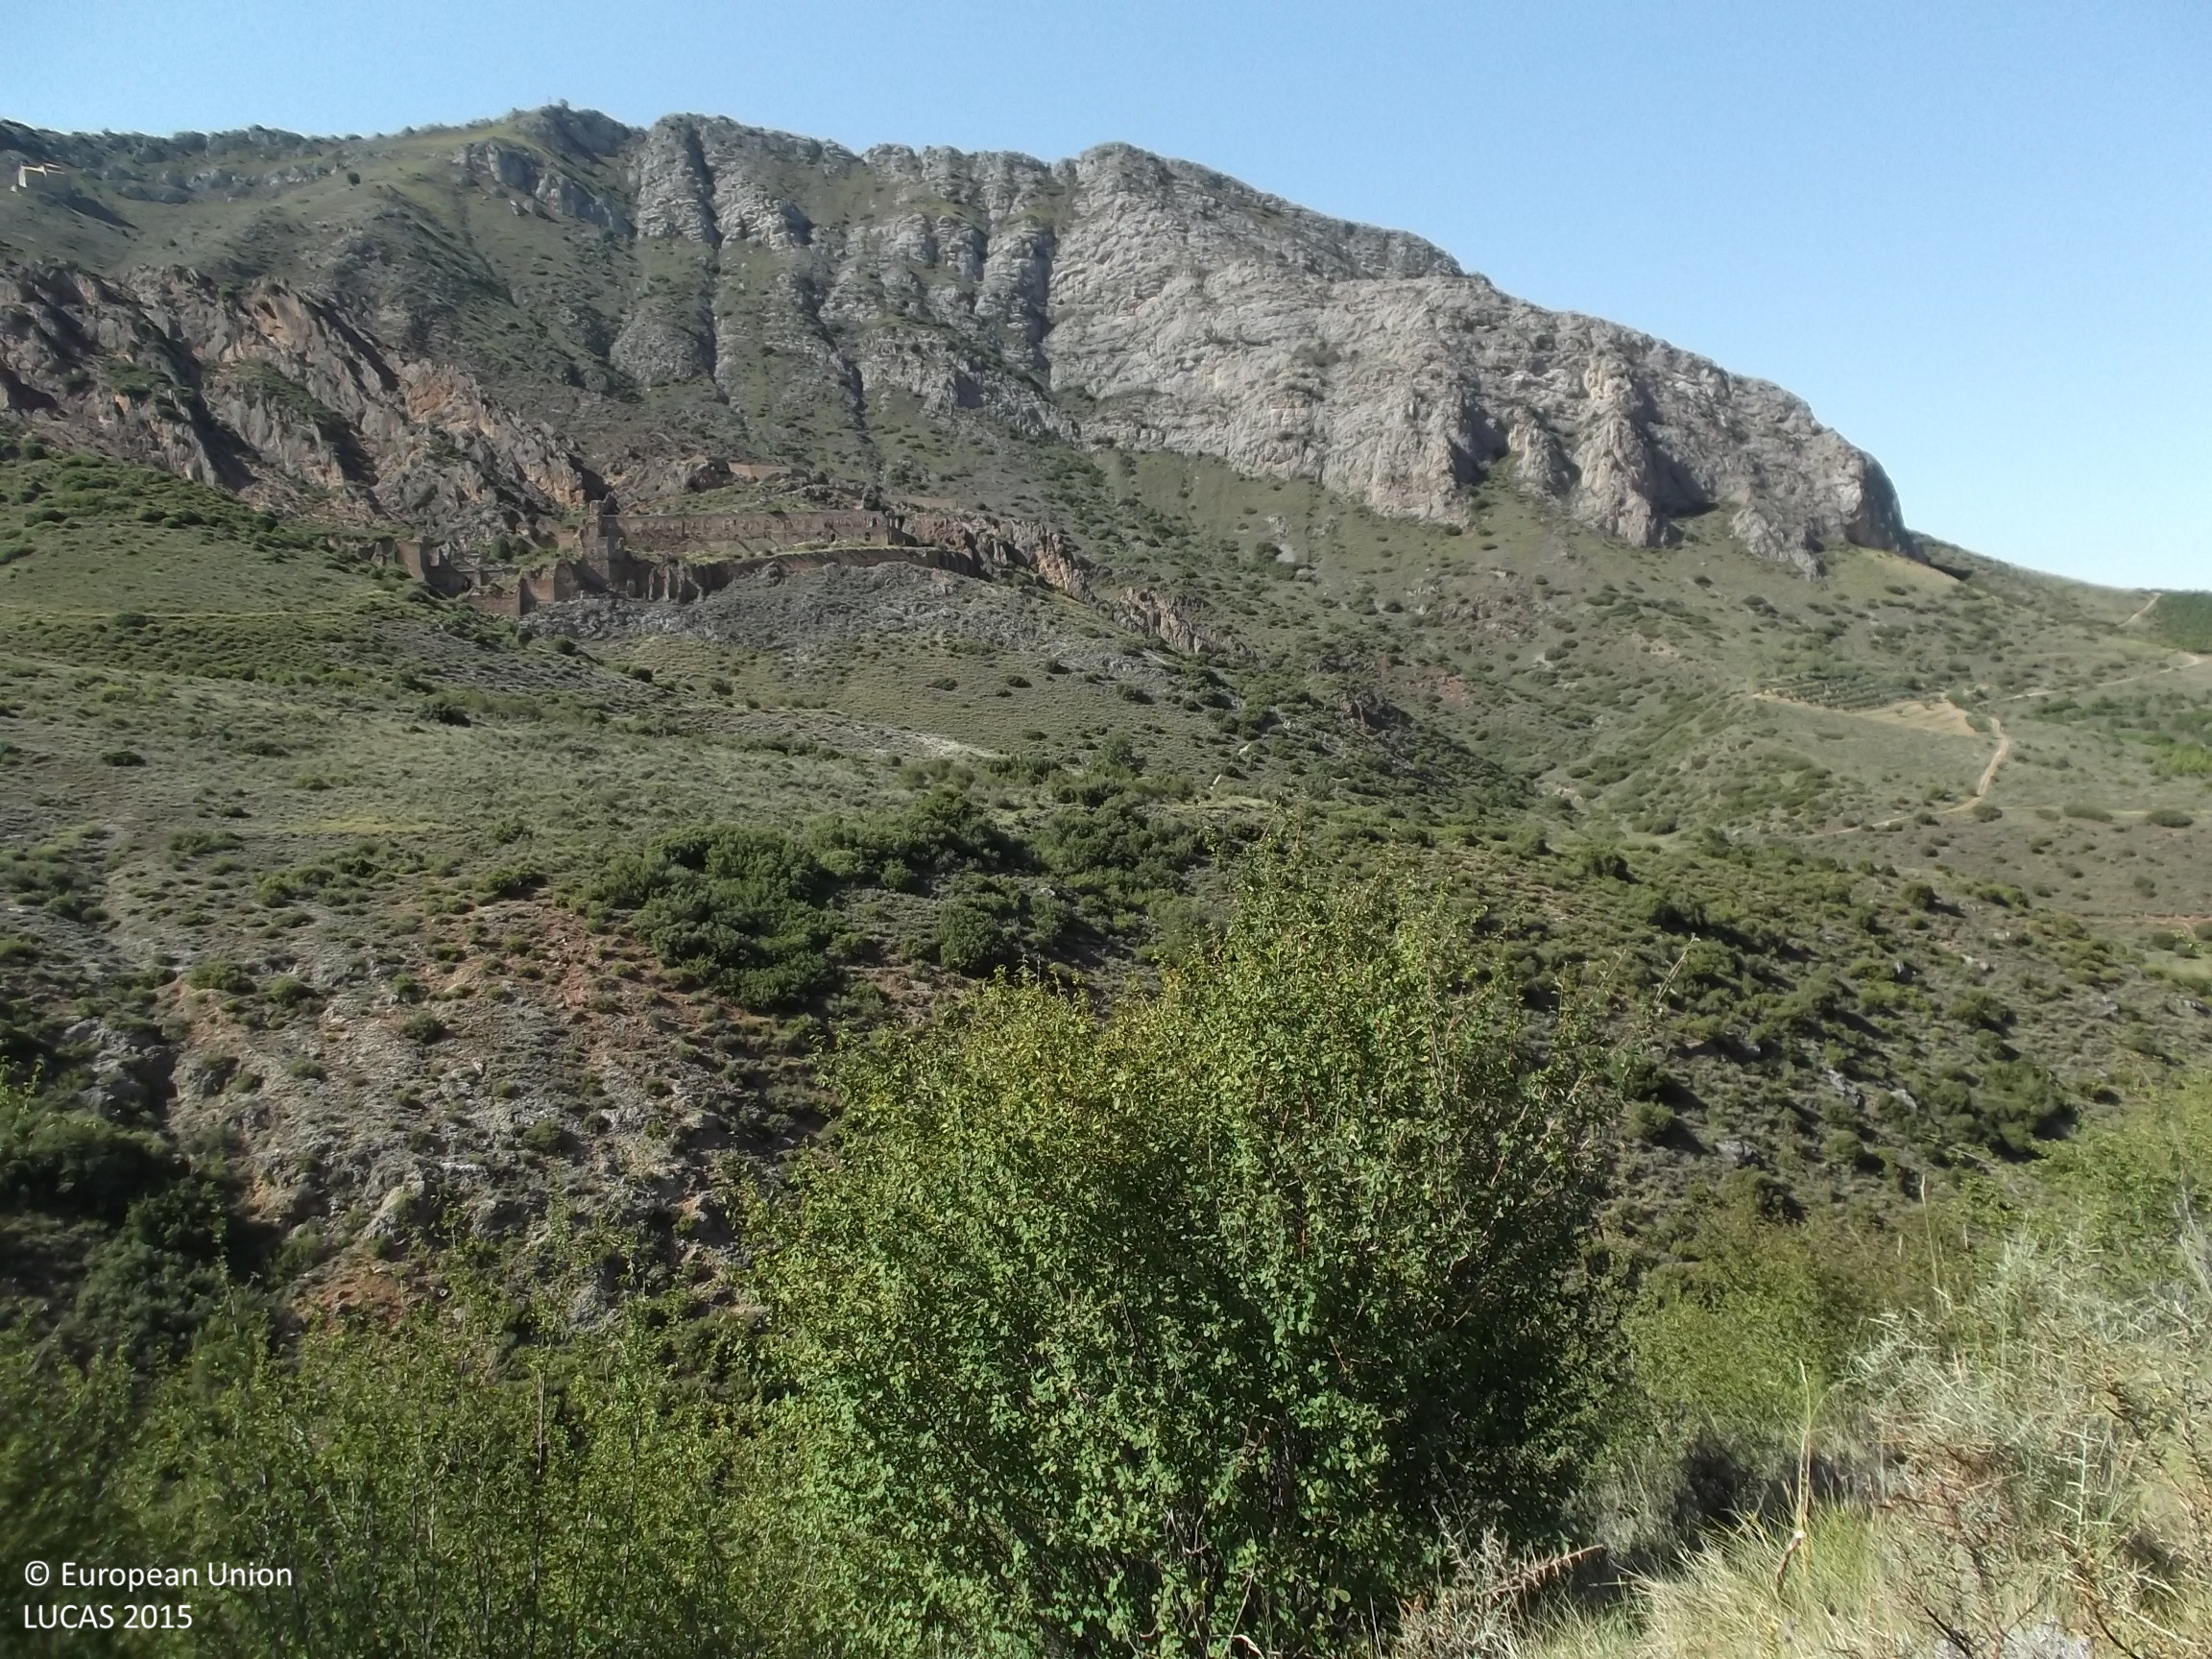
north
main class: Shrubland
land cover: Shrubland with sparse tree cover
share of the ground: 50 - 75 %
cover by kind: shrubs 50 %, herbaceous plants 30 %, unconsolidated bare surface 10 %, broadleaved forest trees 5 %, lichens and mosses 5 %
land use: Semi-natural and natural areas not in use
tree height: < 5 m
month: August
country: ES
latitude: 42.3436
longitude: -2.4121
